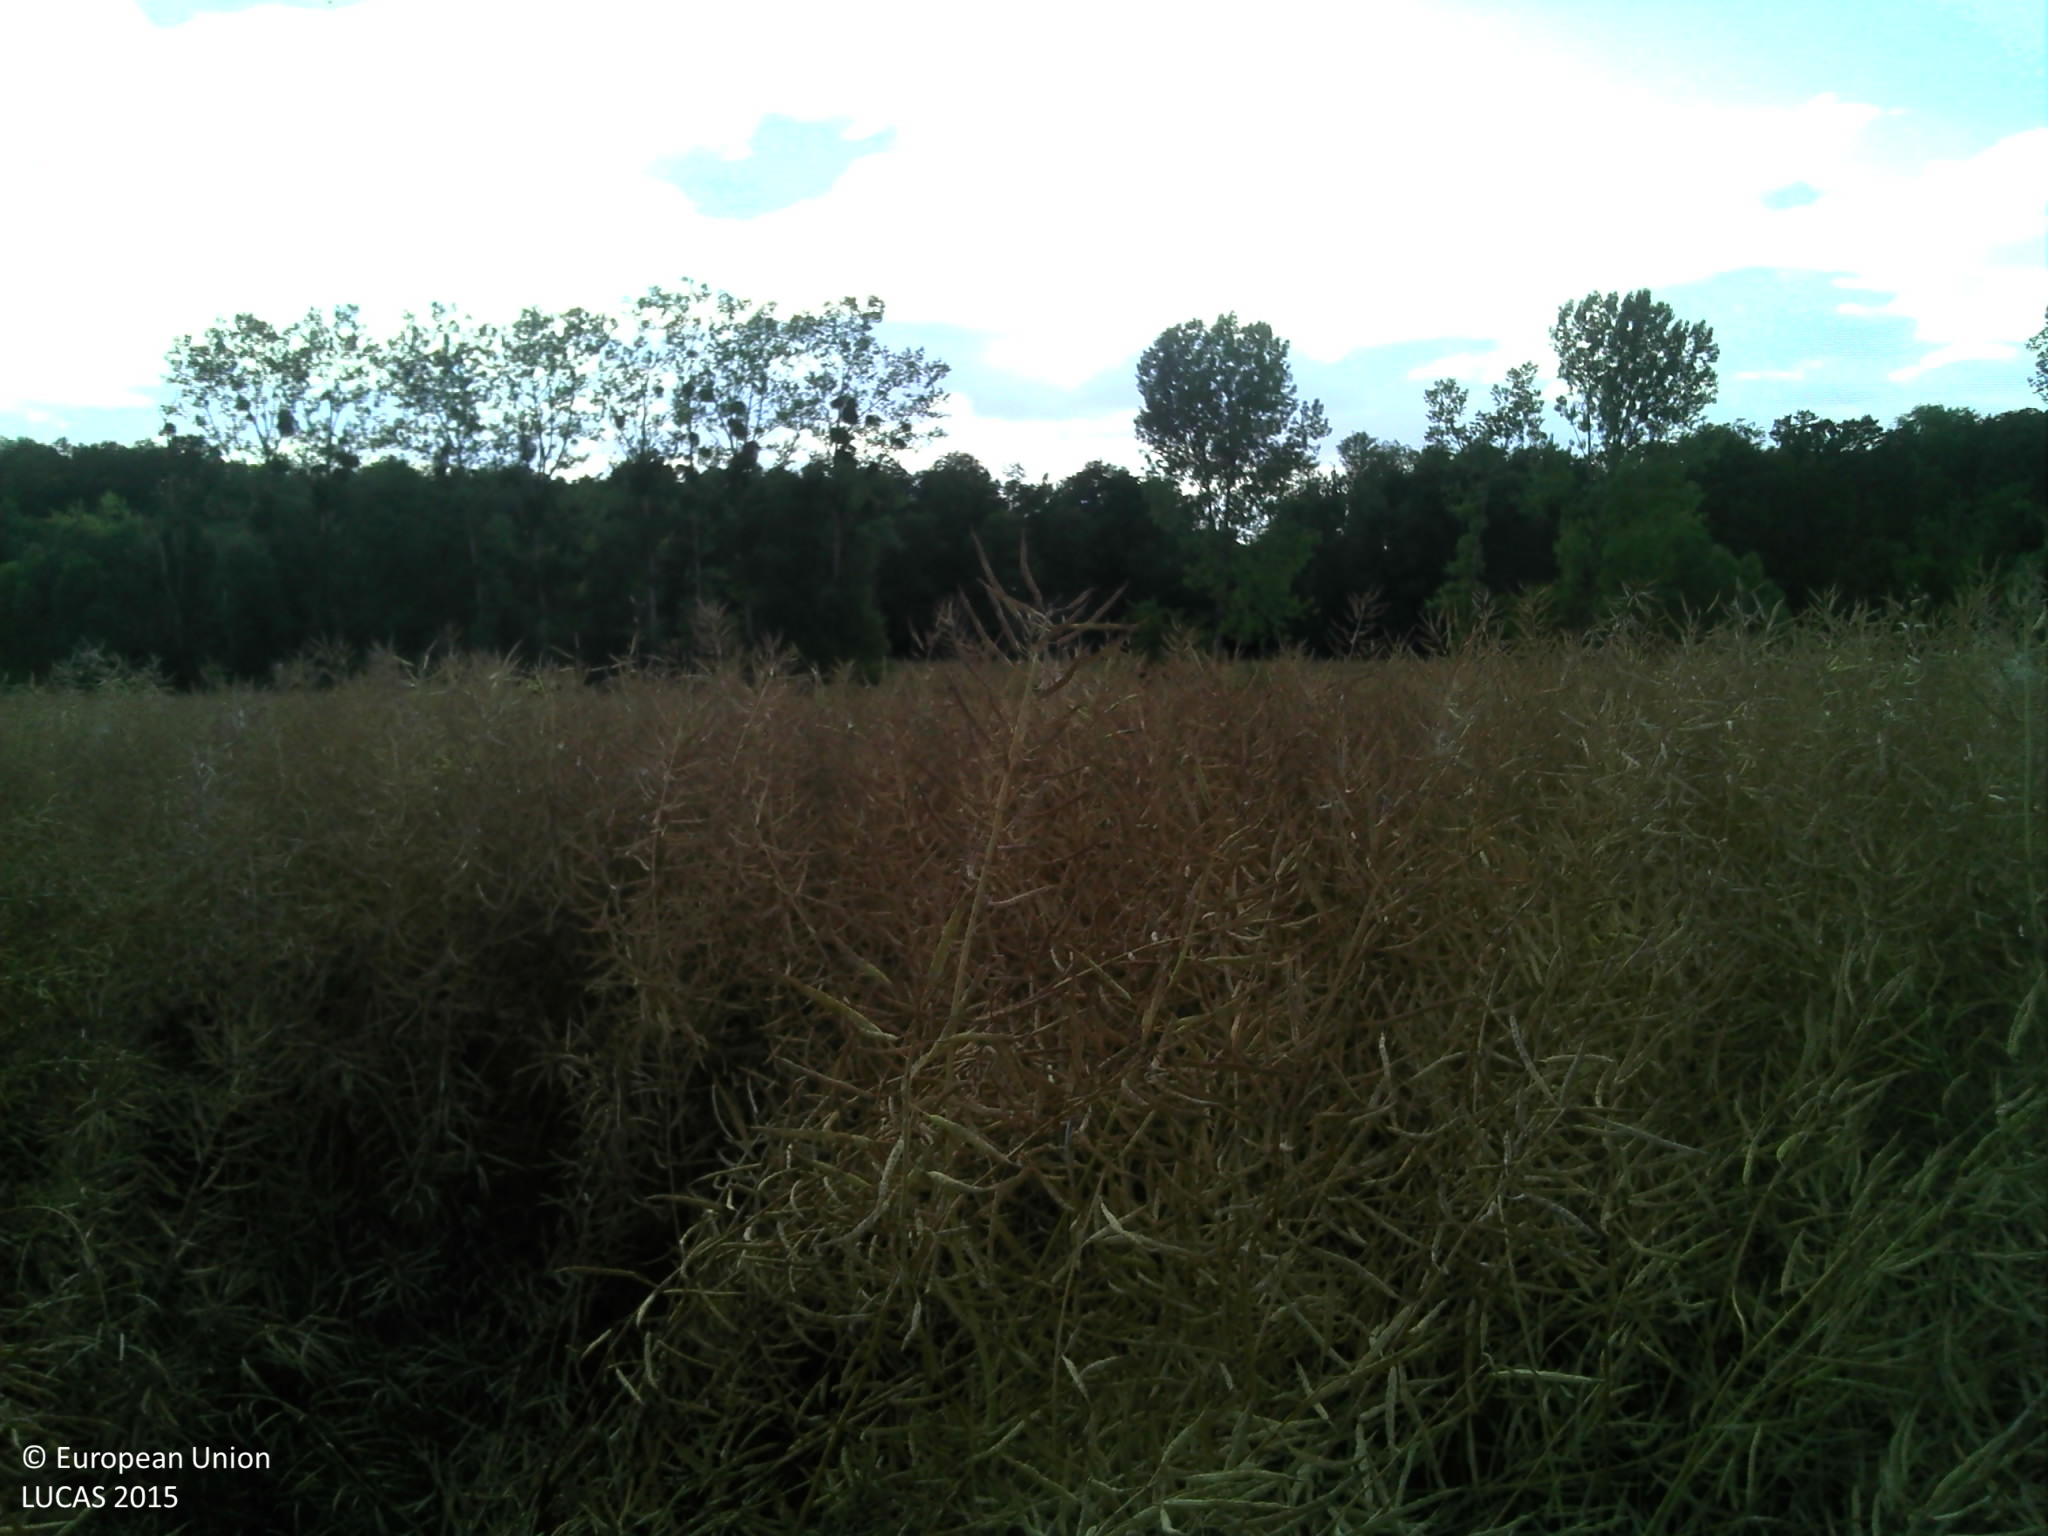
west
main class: Cropland
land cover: Rape and turnip rape
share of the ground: > 75 %
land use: Agriculture (excluding fallow land and kitchen gardens)
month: July
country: FR
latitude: 48.9628
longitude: 5.1220
